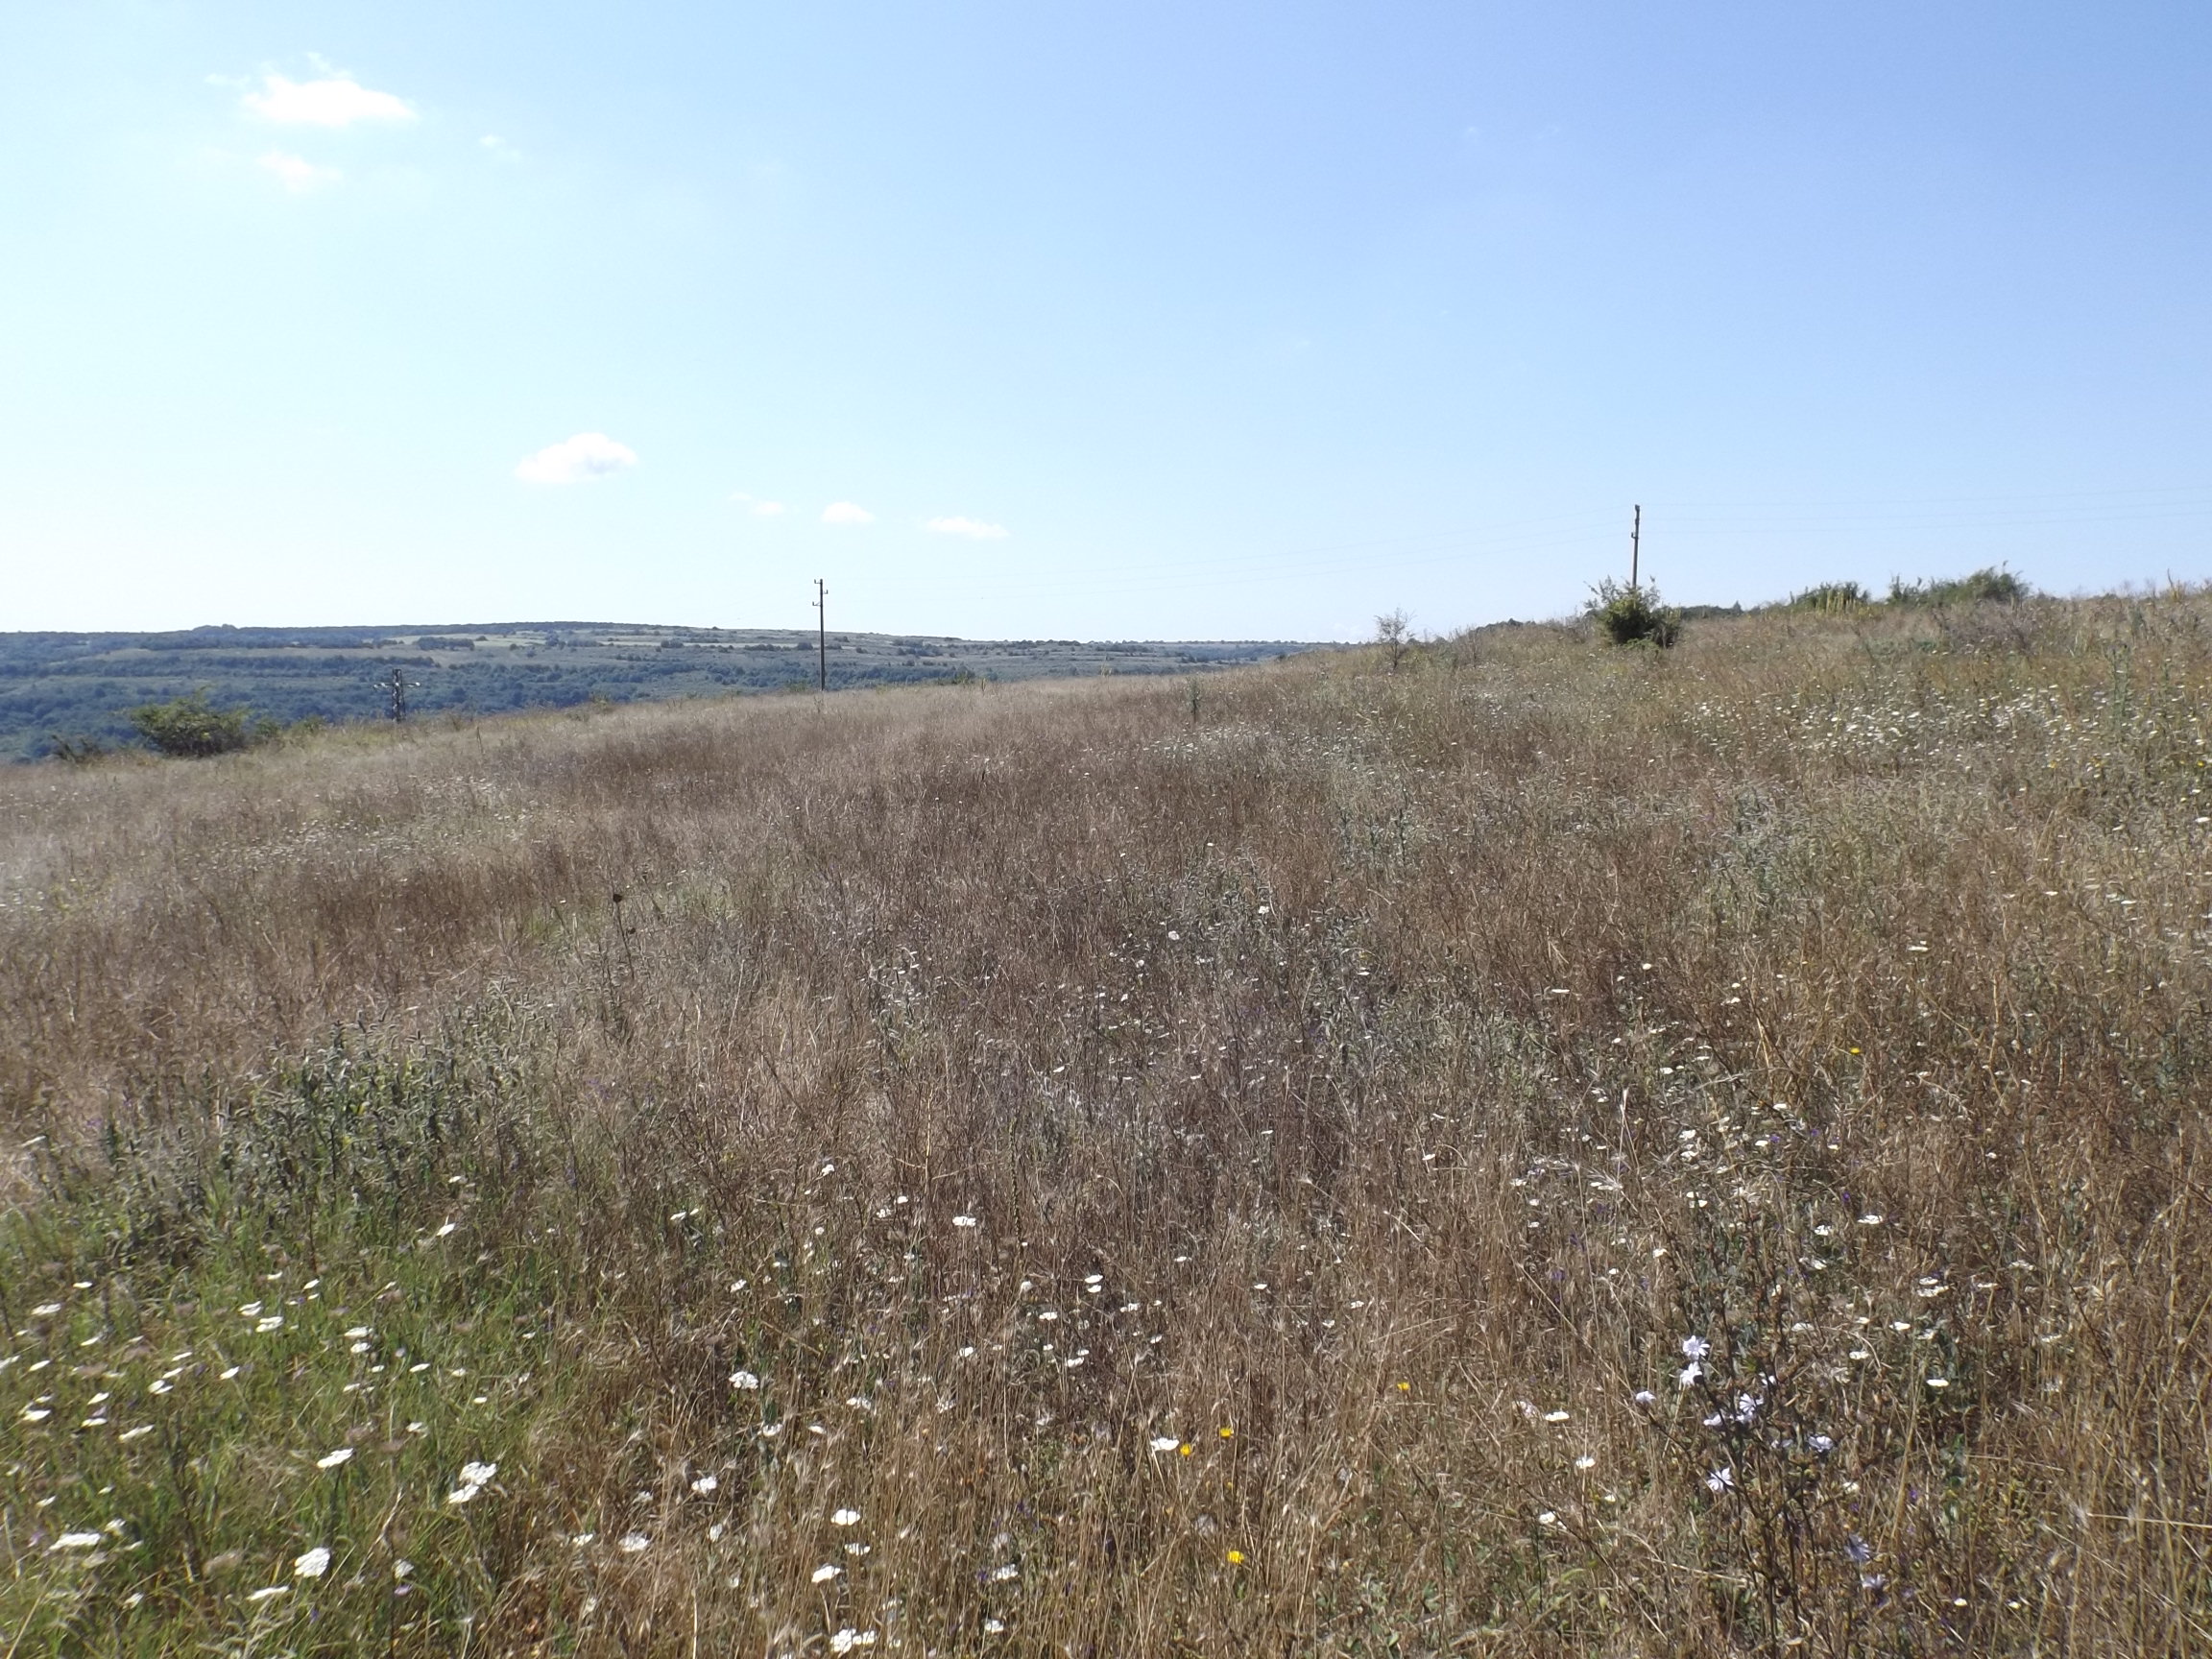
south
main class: Grassland
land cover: Grassland without tree/shrub cover
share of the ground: > 75 %
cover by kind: herbaceous plants 100 %
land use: Semi-natural and natural areas not in use
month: August
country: BG
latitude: 43.3559
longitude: 27.9715
